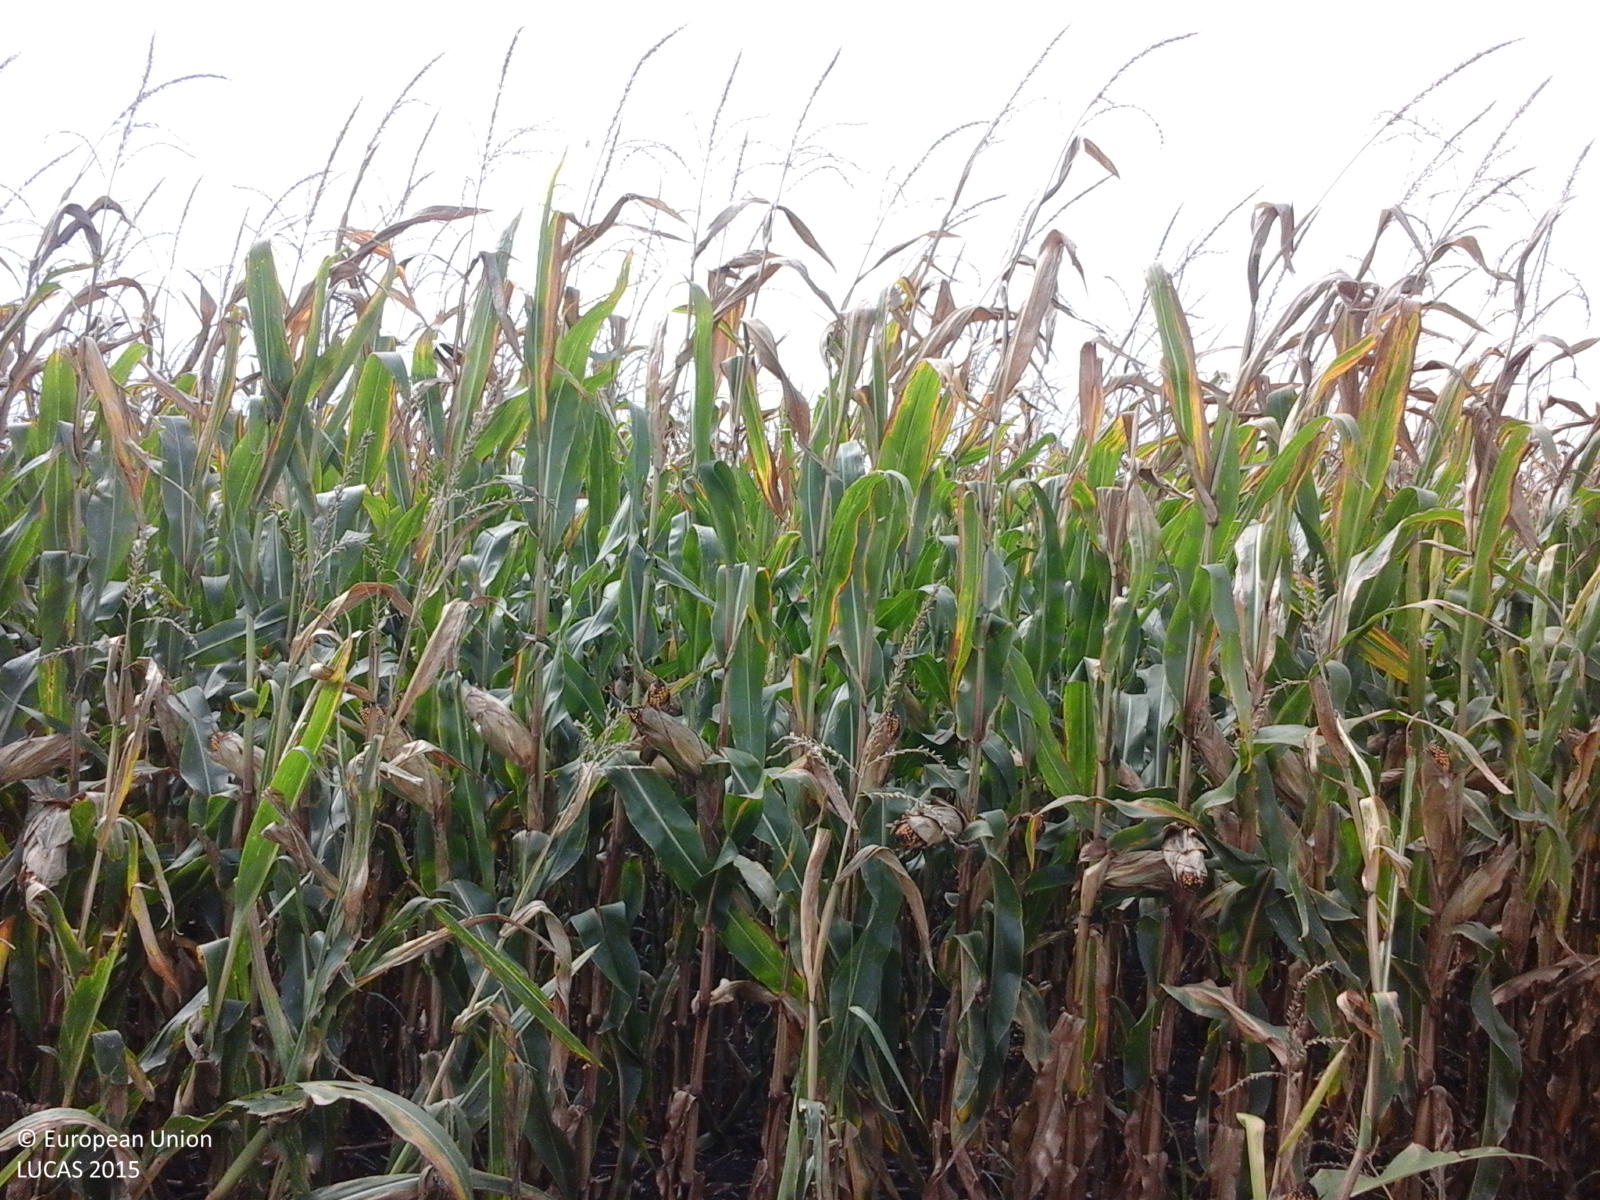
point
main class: Cropland
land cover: Maize
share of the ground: > 75 %
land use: Agriculture (excluding fallow land and kitchen gardens)
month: August
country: RO
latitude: 46.2659
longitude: 20.8893
